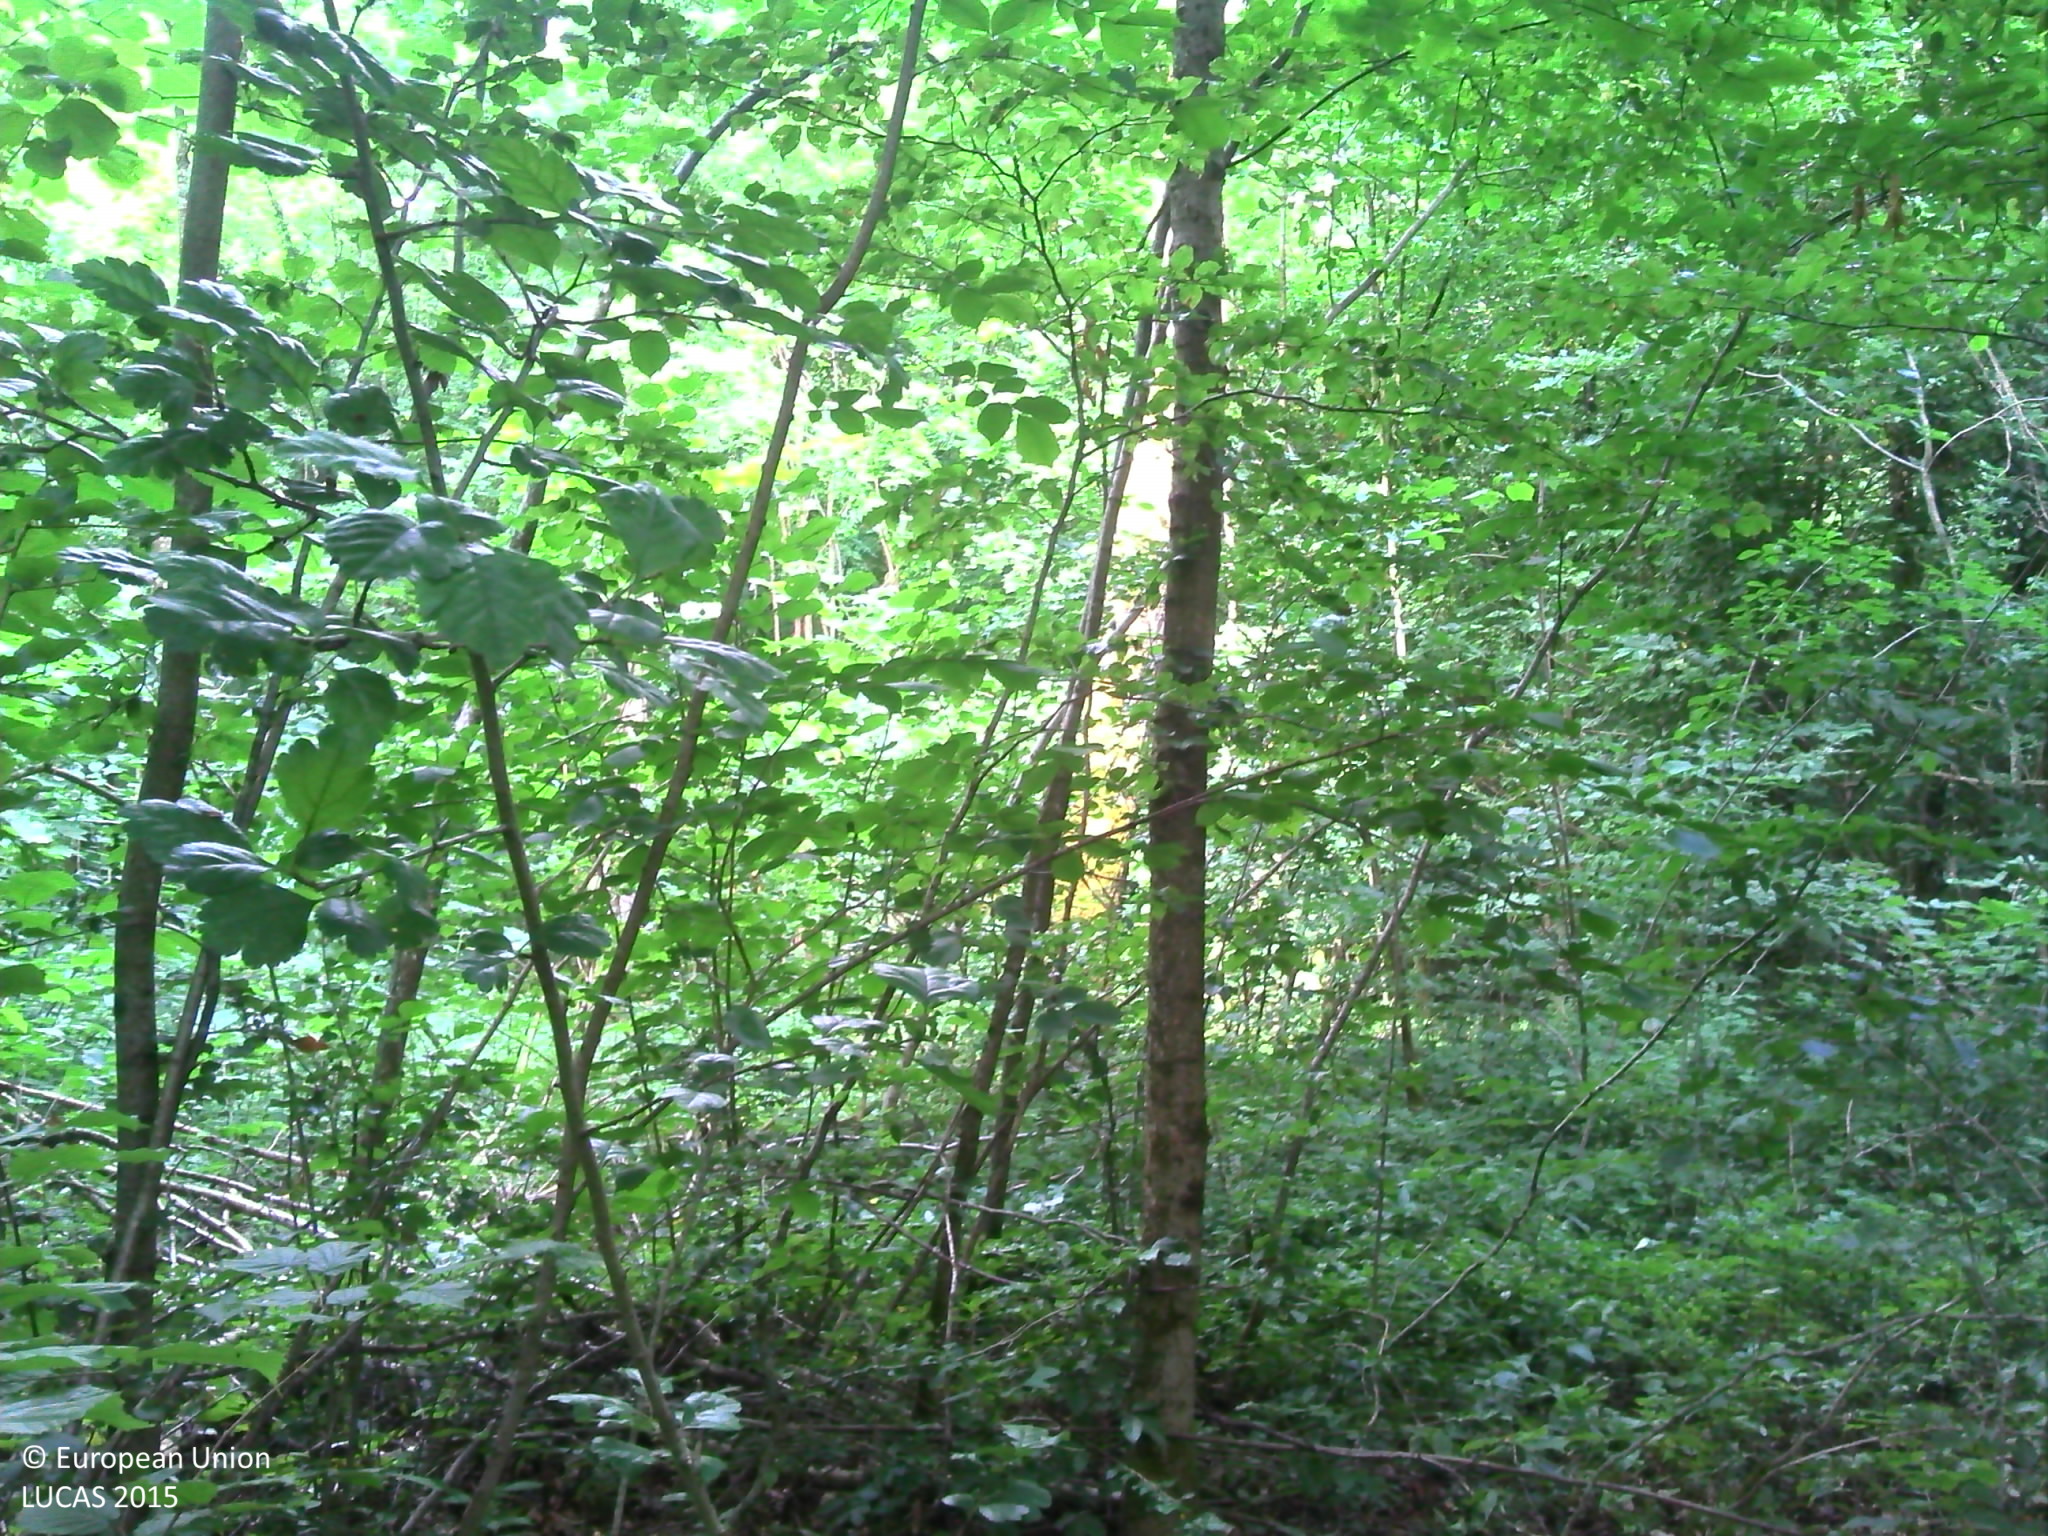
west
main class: Woodland
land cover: Broadleaved woodland
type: mesophytic deciduous forest
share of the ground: > 75 %
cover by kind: broadleaved forest trees 95 %, shrubs 5 %
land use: Forestry
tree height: > 5 m
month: July
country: BE
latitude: 49.5238
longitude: 5.6195
